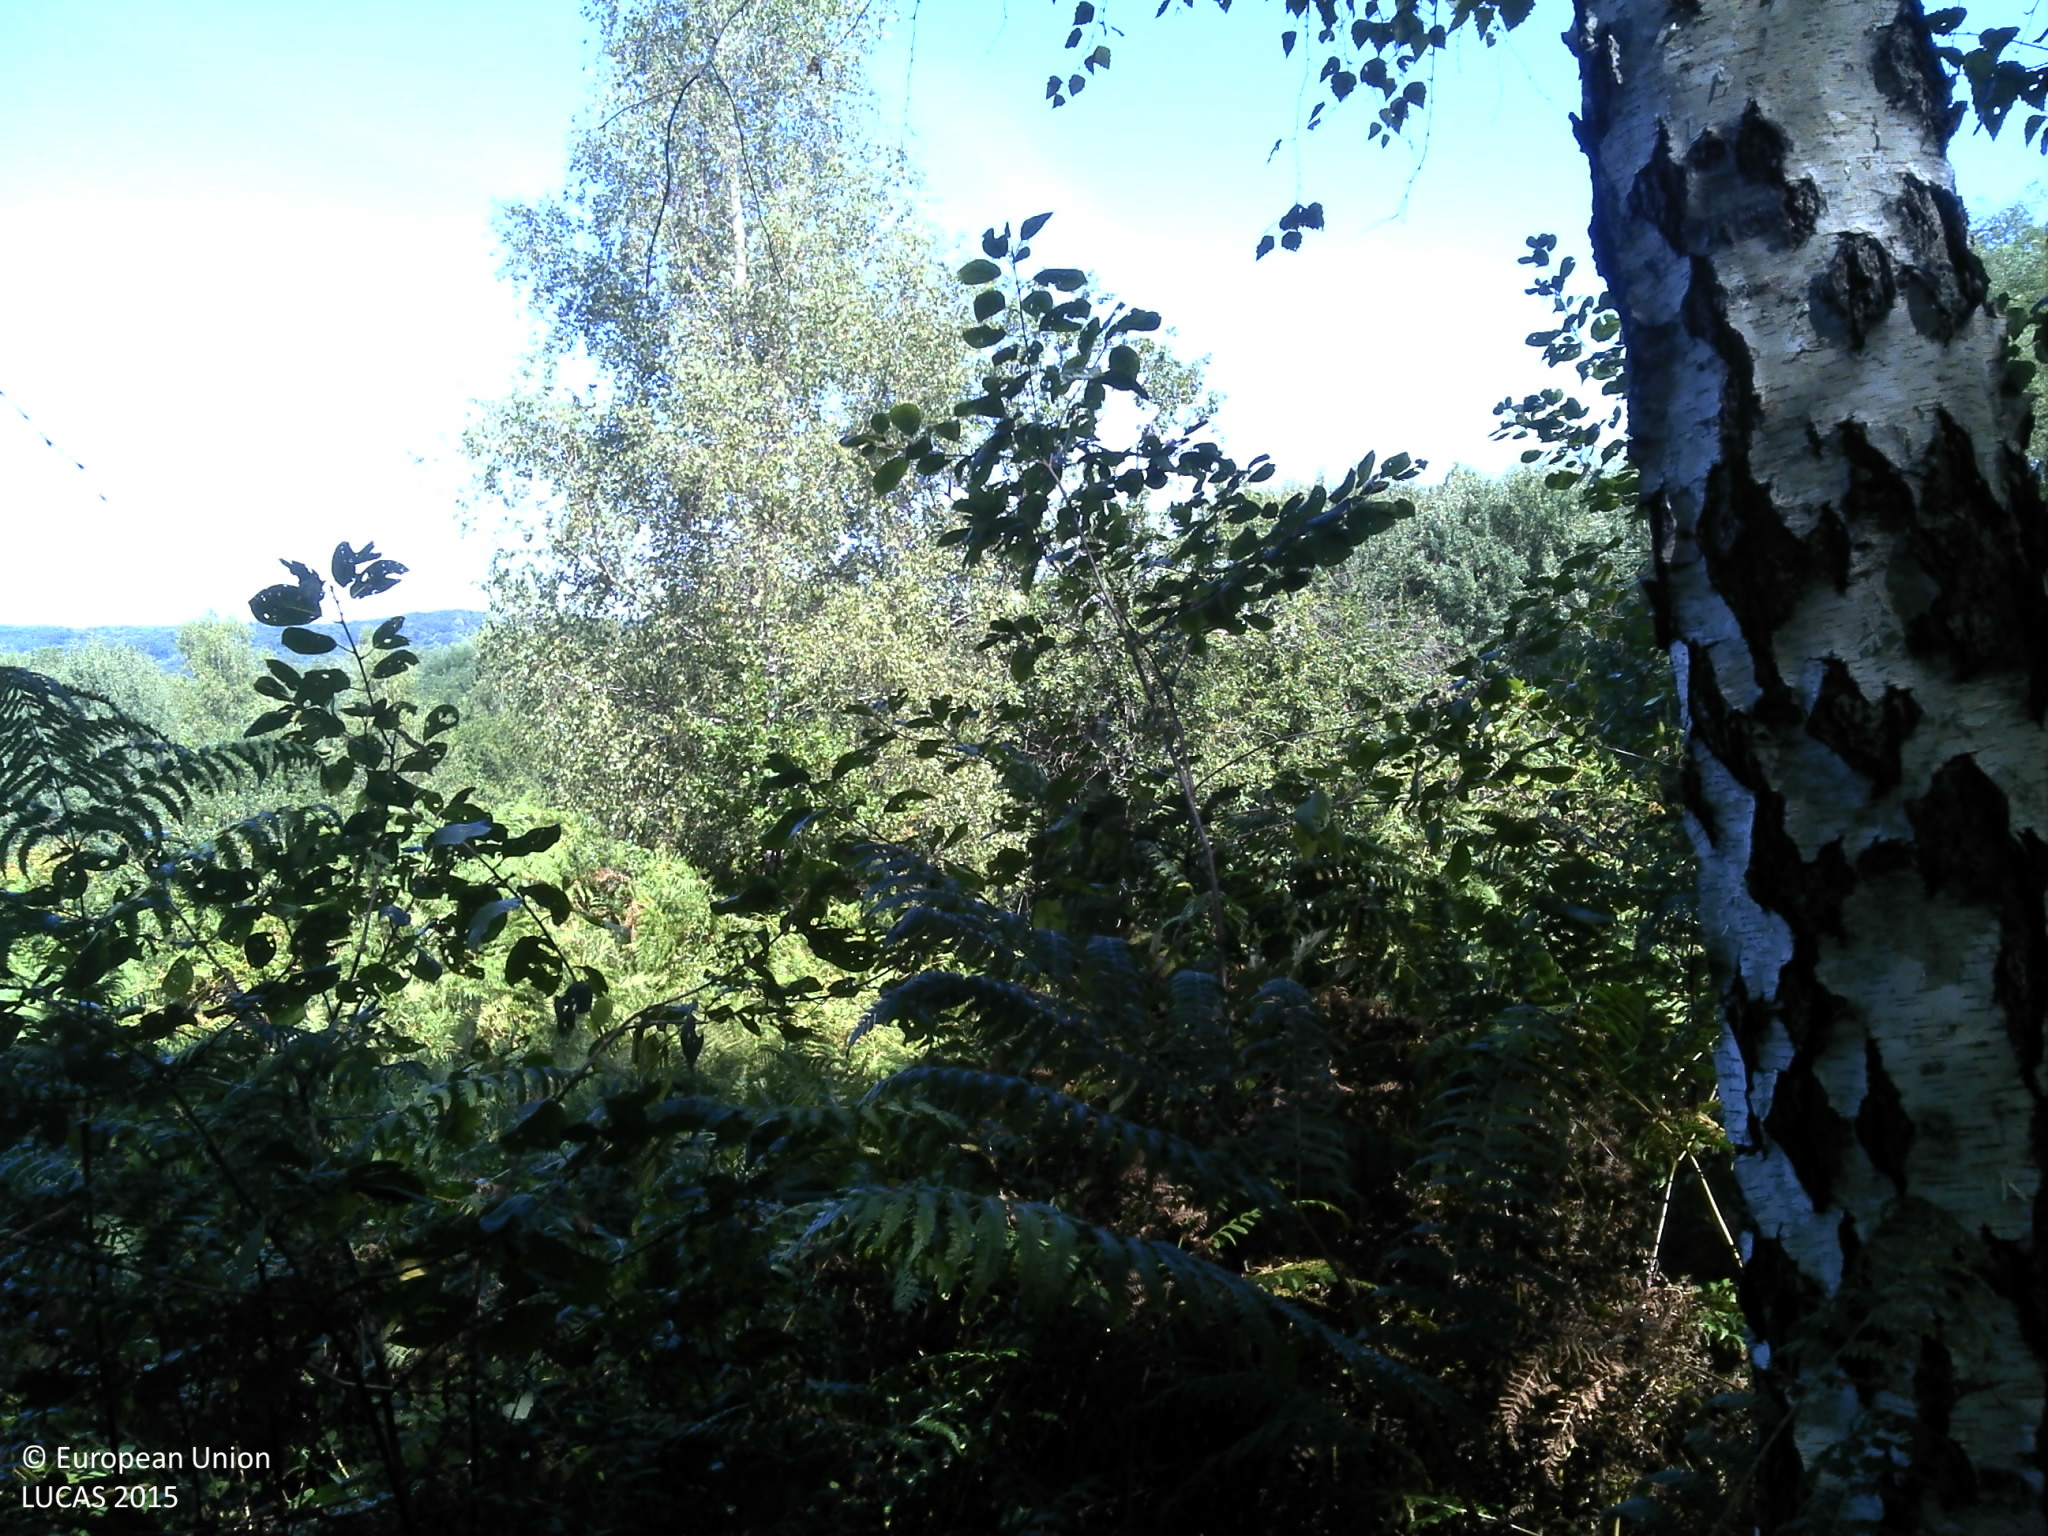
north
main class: Woodland
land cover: Broadleaved woodland
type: non-riverine alder, birch or aspen forest
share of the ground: > 75 %
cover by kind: broadleaved forest trees 100 %
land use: Forestry
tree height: > 5 m
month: August
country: HR
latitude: 45.2704
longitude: 16.4595
